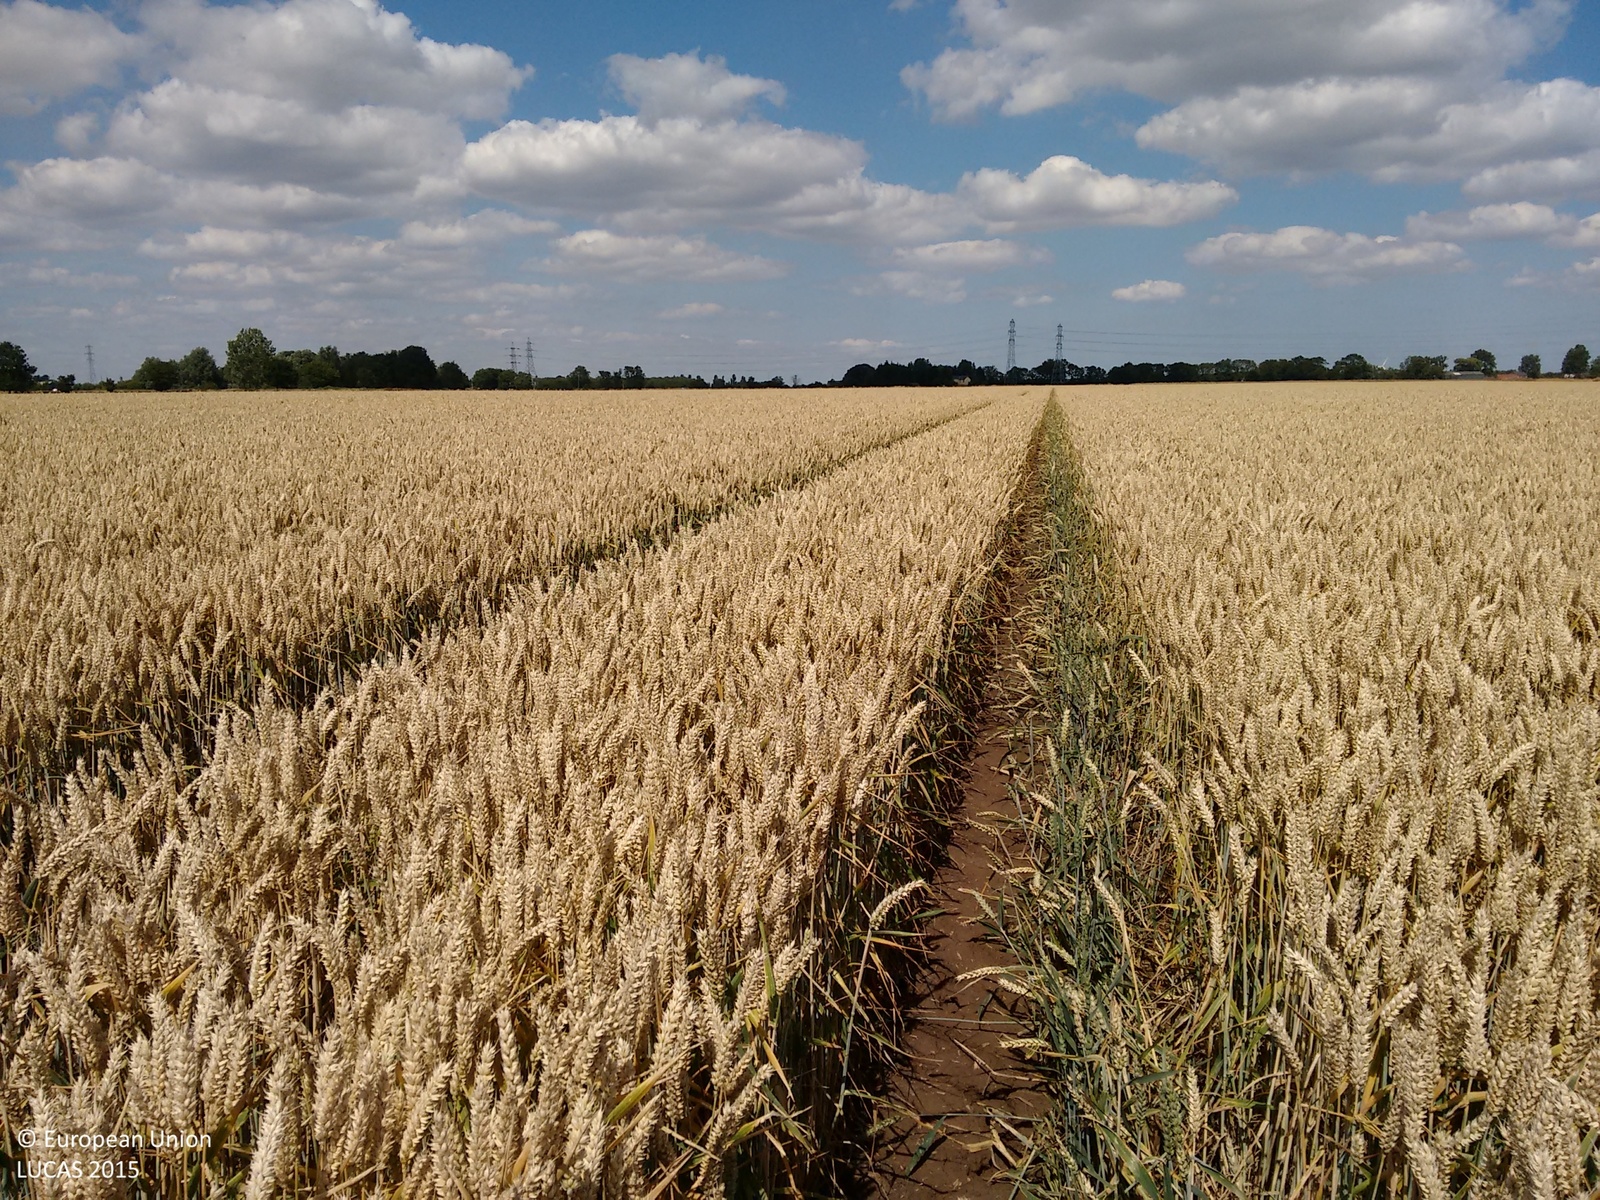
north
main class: Cropland
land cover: Common wheat
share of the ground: > 75 %
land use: Agriculture (excluding fallow land and kitchen gardens)
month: July
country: GB
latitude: 52.7269
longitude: 0.3614
